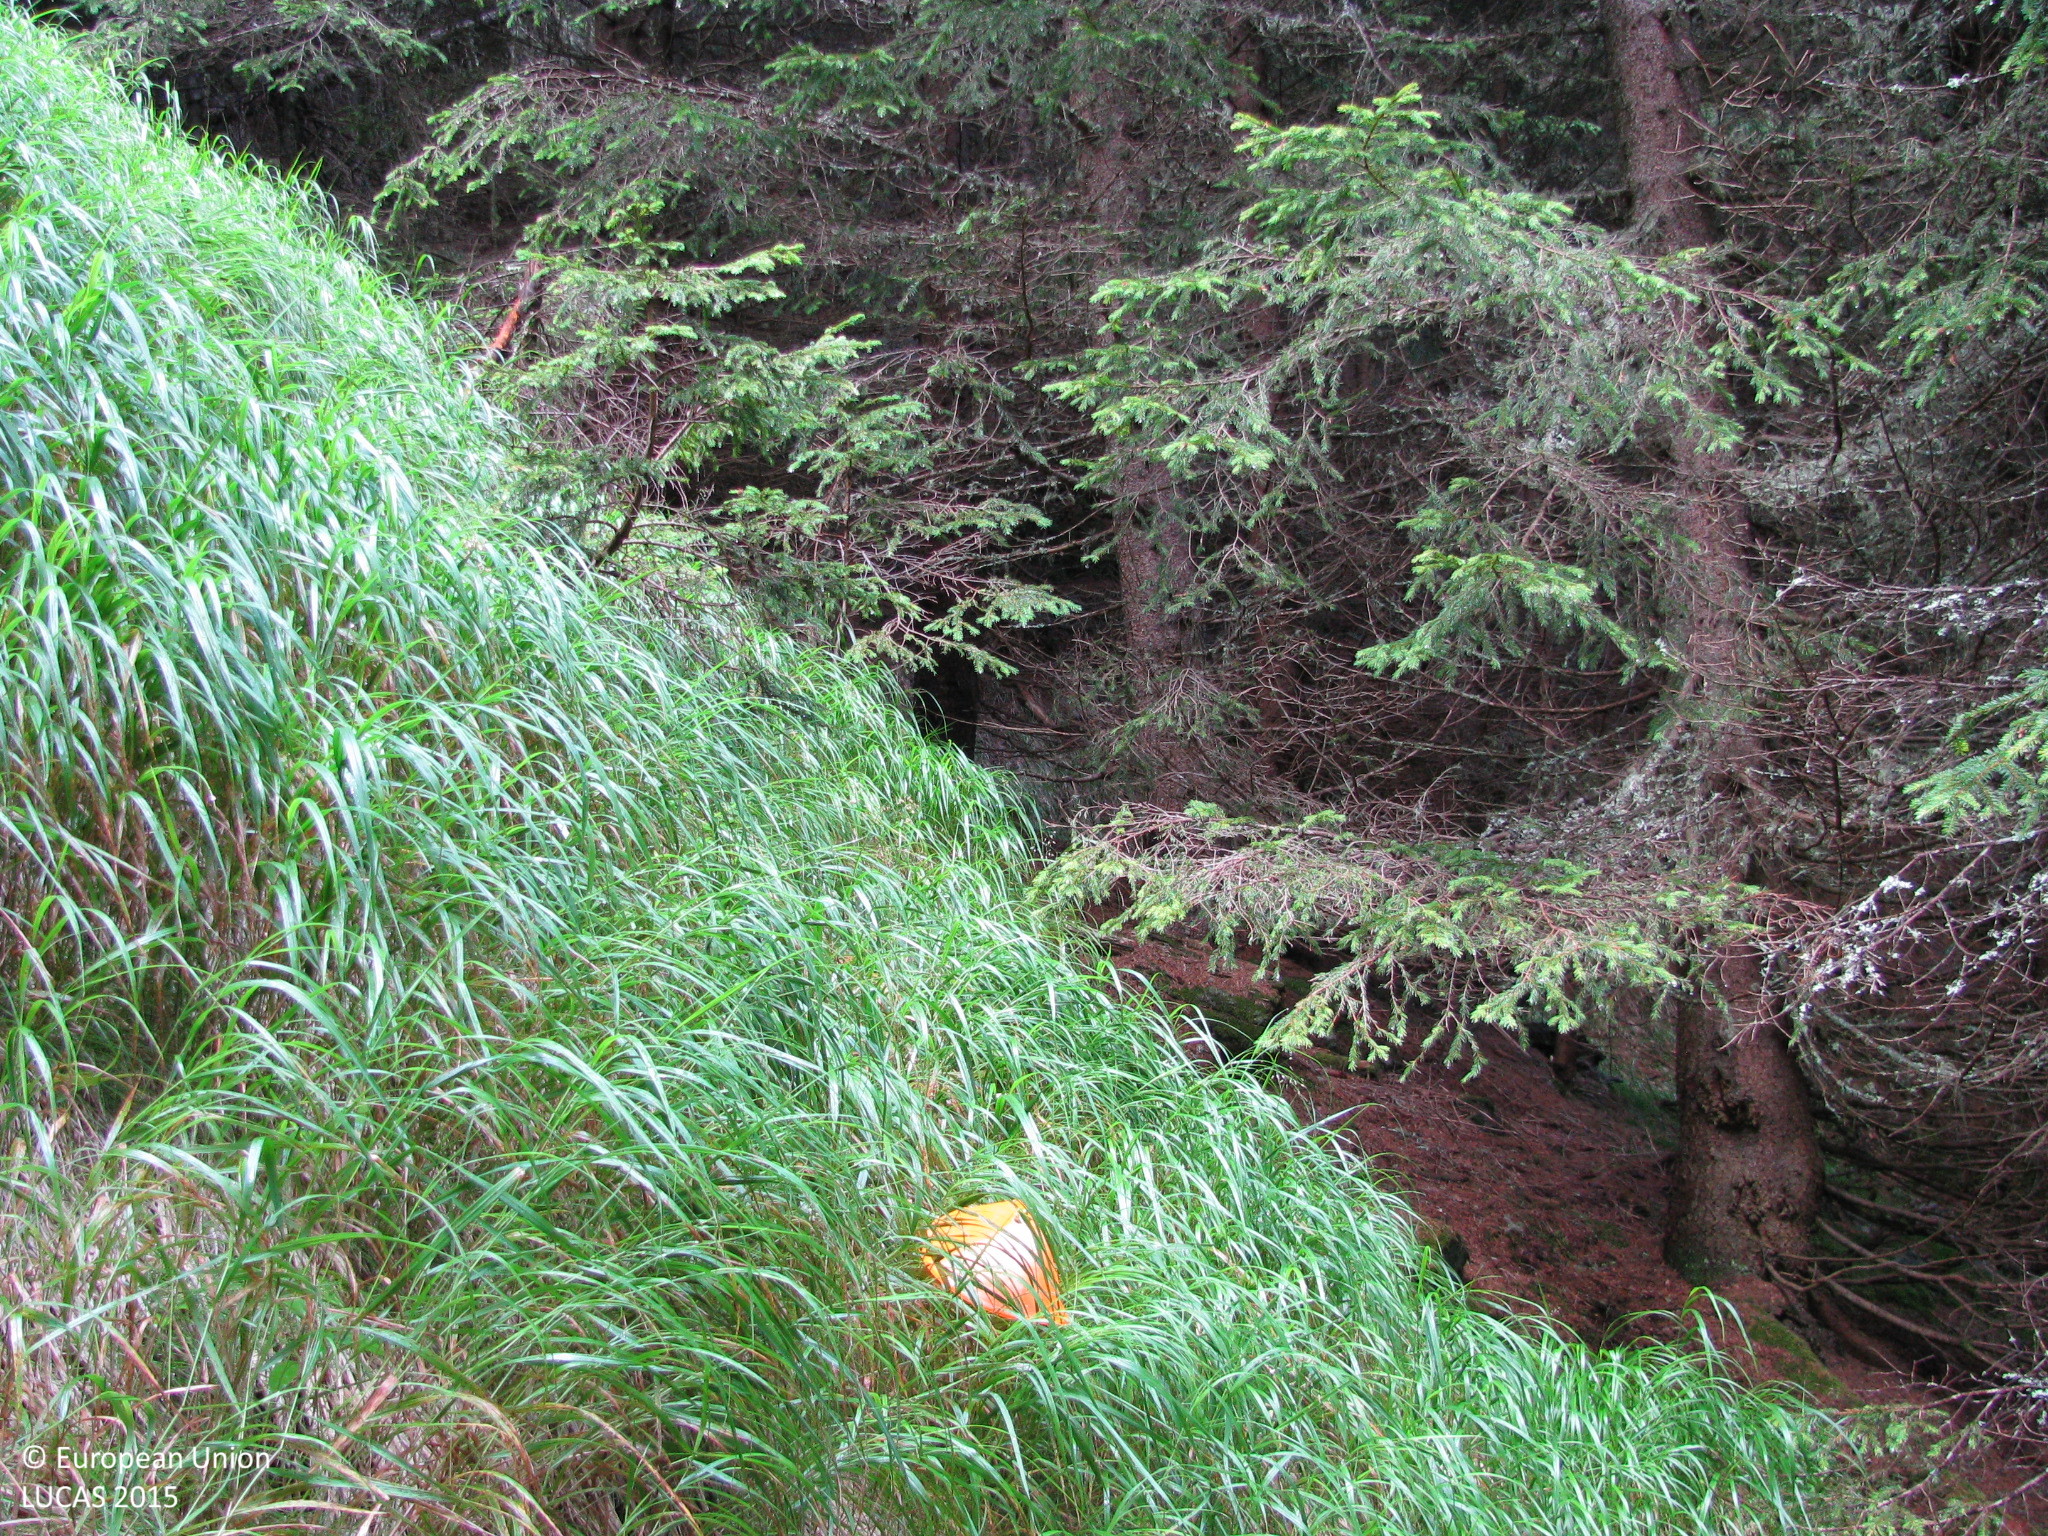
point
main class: Woodland
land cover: Spruce dominated coniferous woodland
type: alpine coniferous forest
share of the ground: > 75 %
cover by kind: coniferous forest trees 90 %, herbaceous plants 10 %
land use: Forestry
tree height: > 5 m
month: July
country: AT
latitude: 46.8234
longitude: 12.6323
